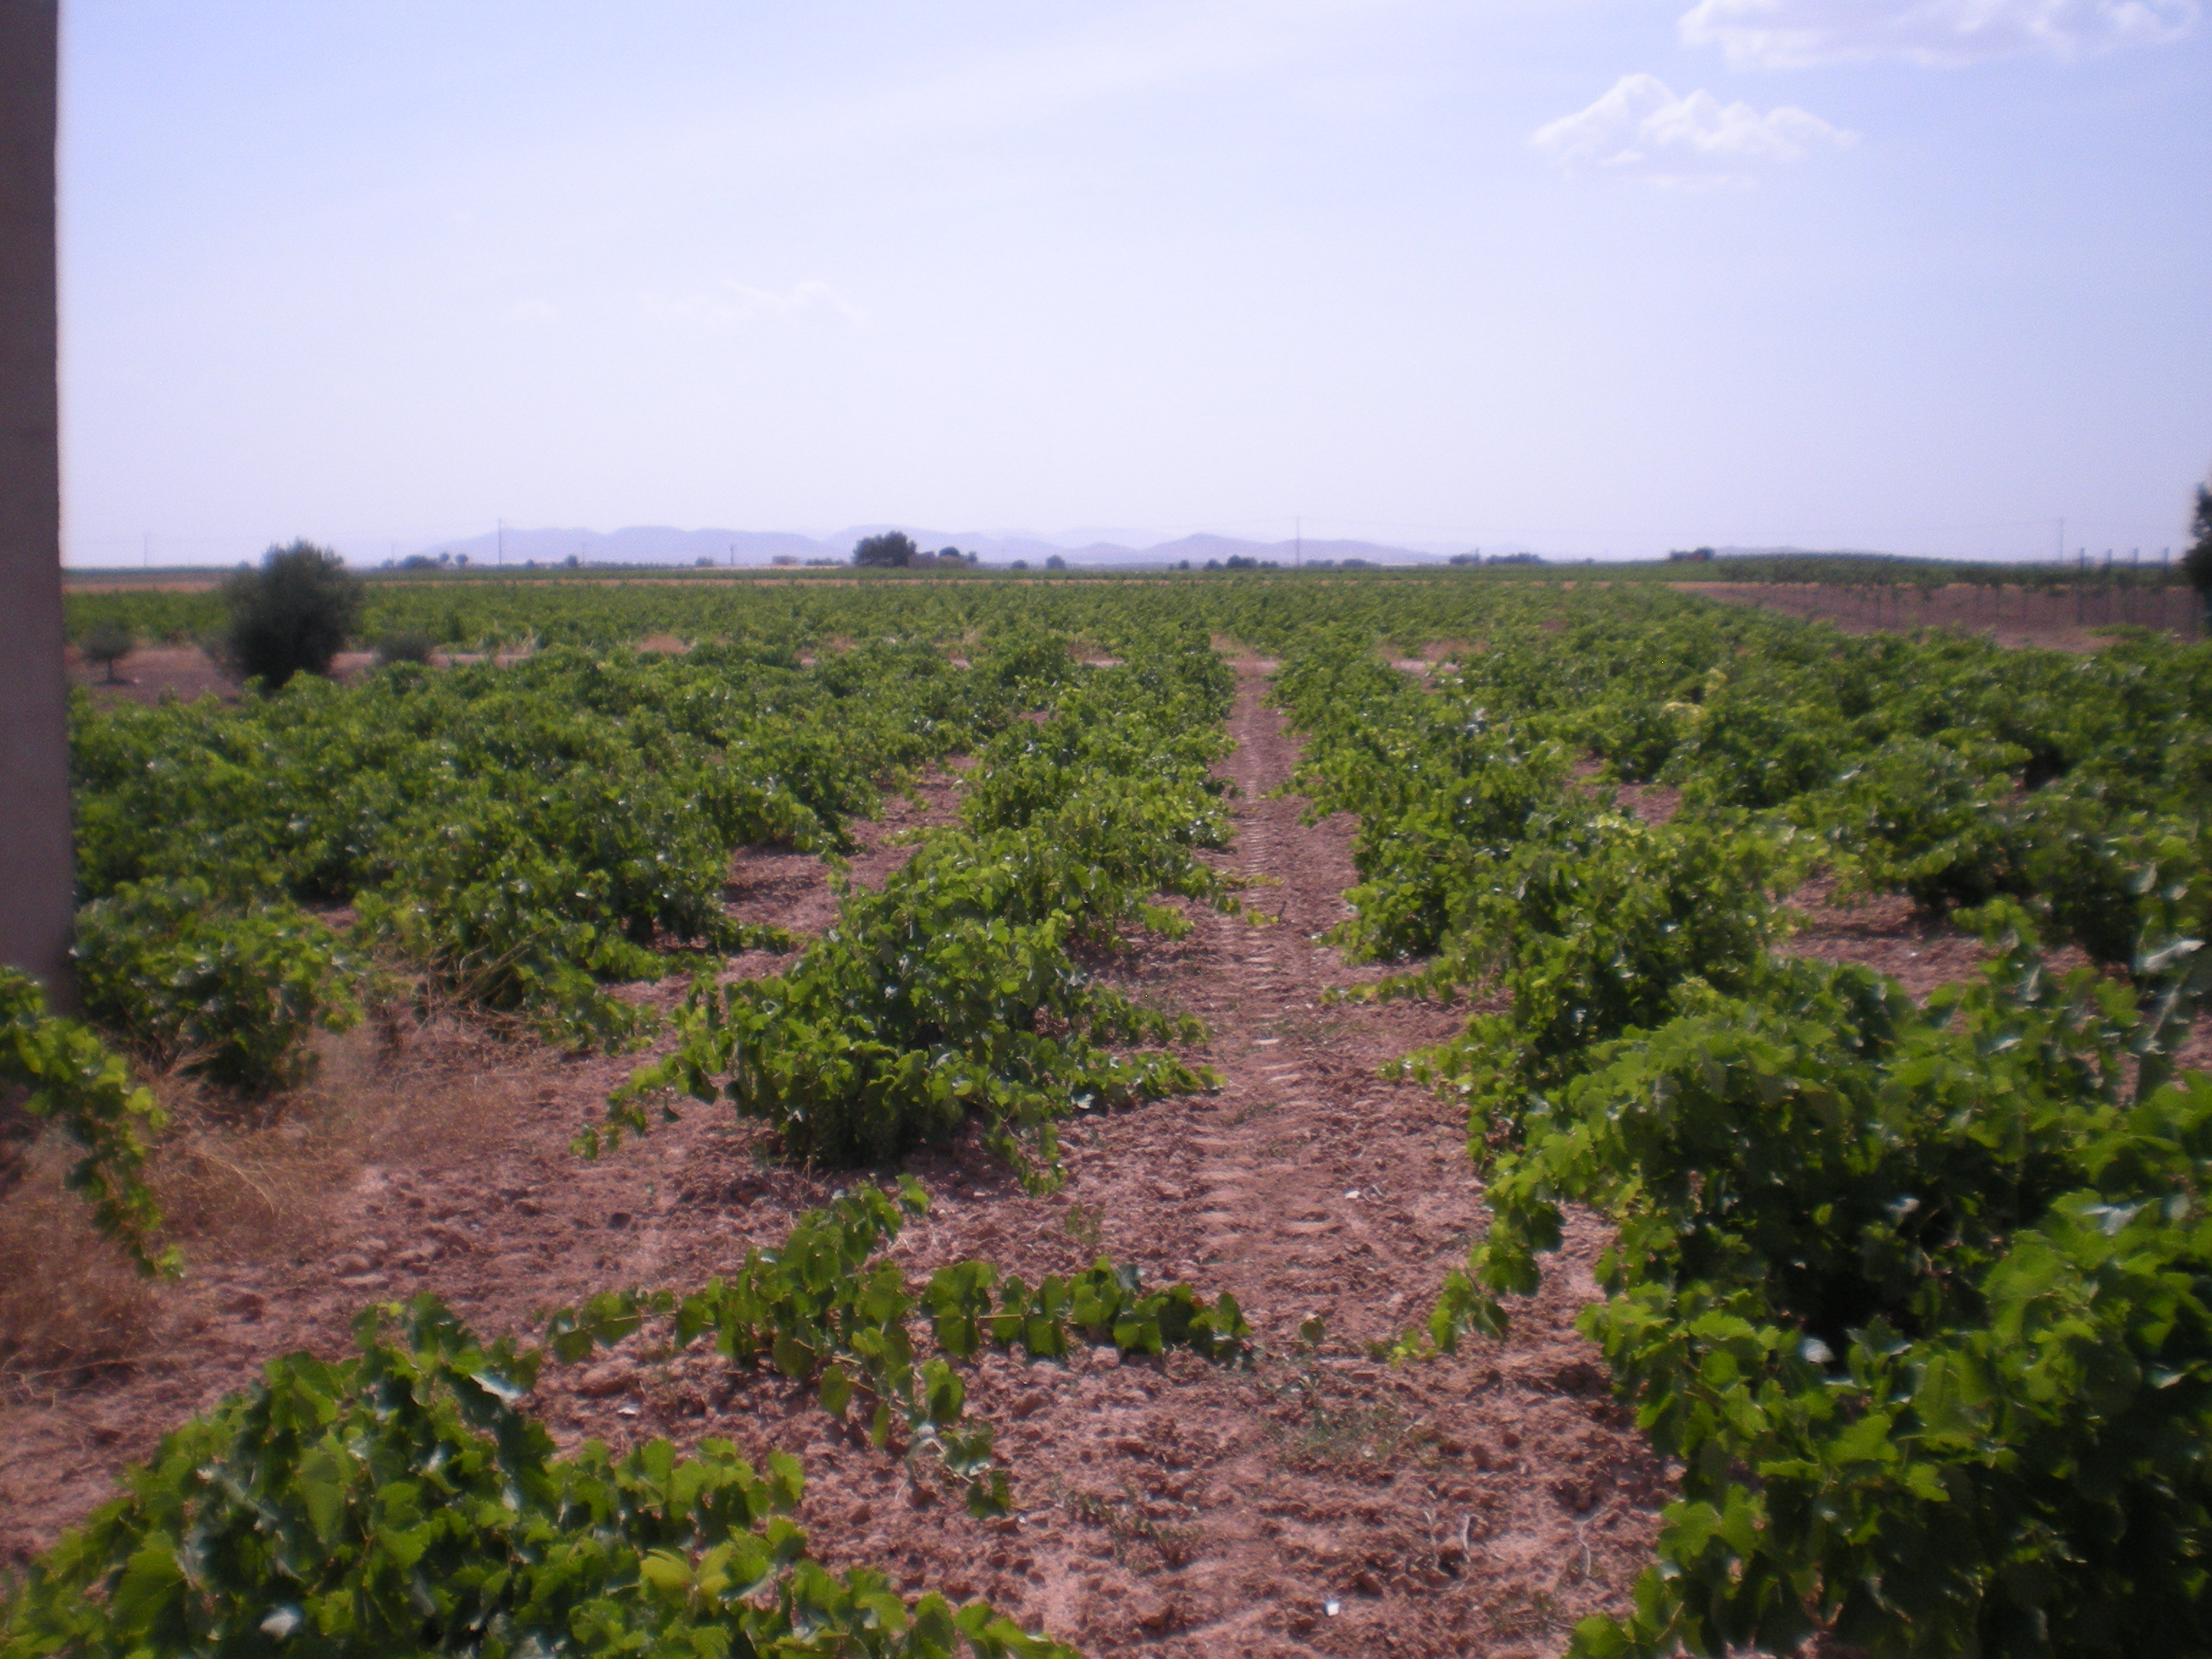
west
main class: Cropland
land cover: Vineyards
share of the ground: 25 - 50 %
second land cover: Other bare soil
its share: > 75 %
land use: Agriculture (excluding fallow land and kitchen gardens)
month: July
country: ES
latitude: 39.3513
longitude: -3.2114
